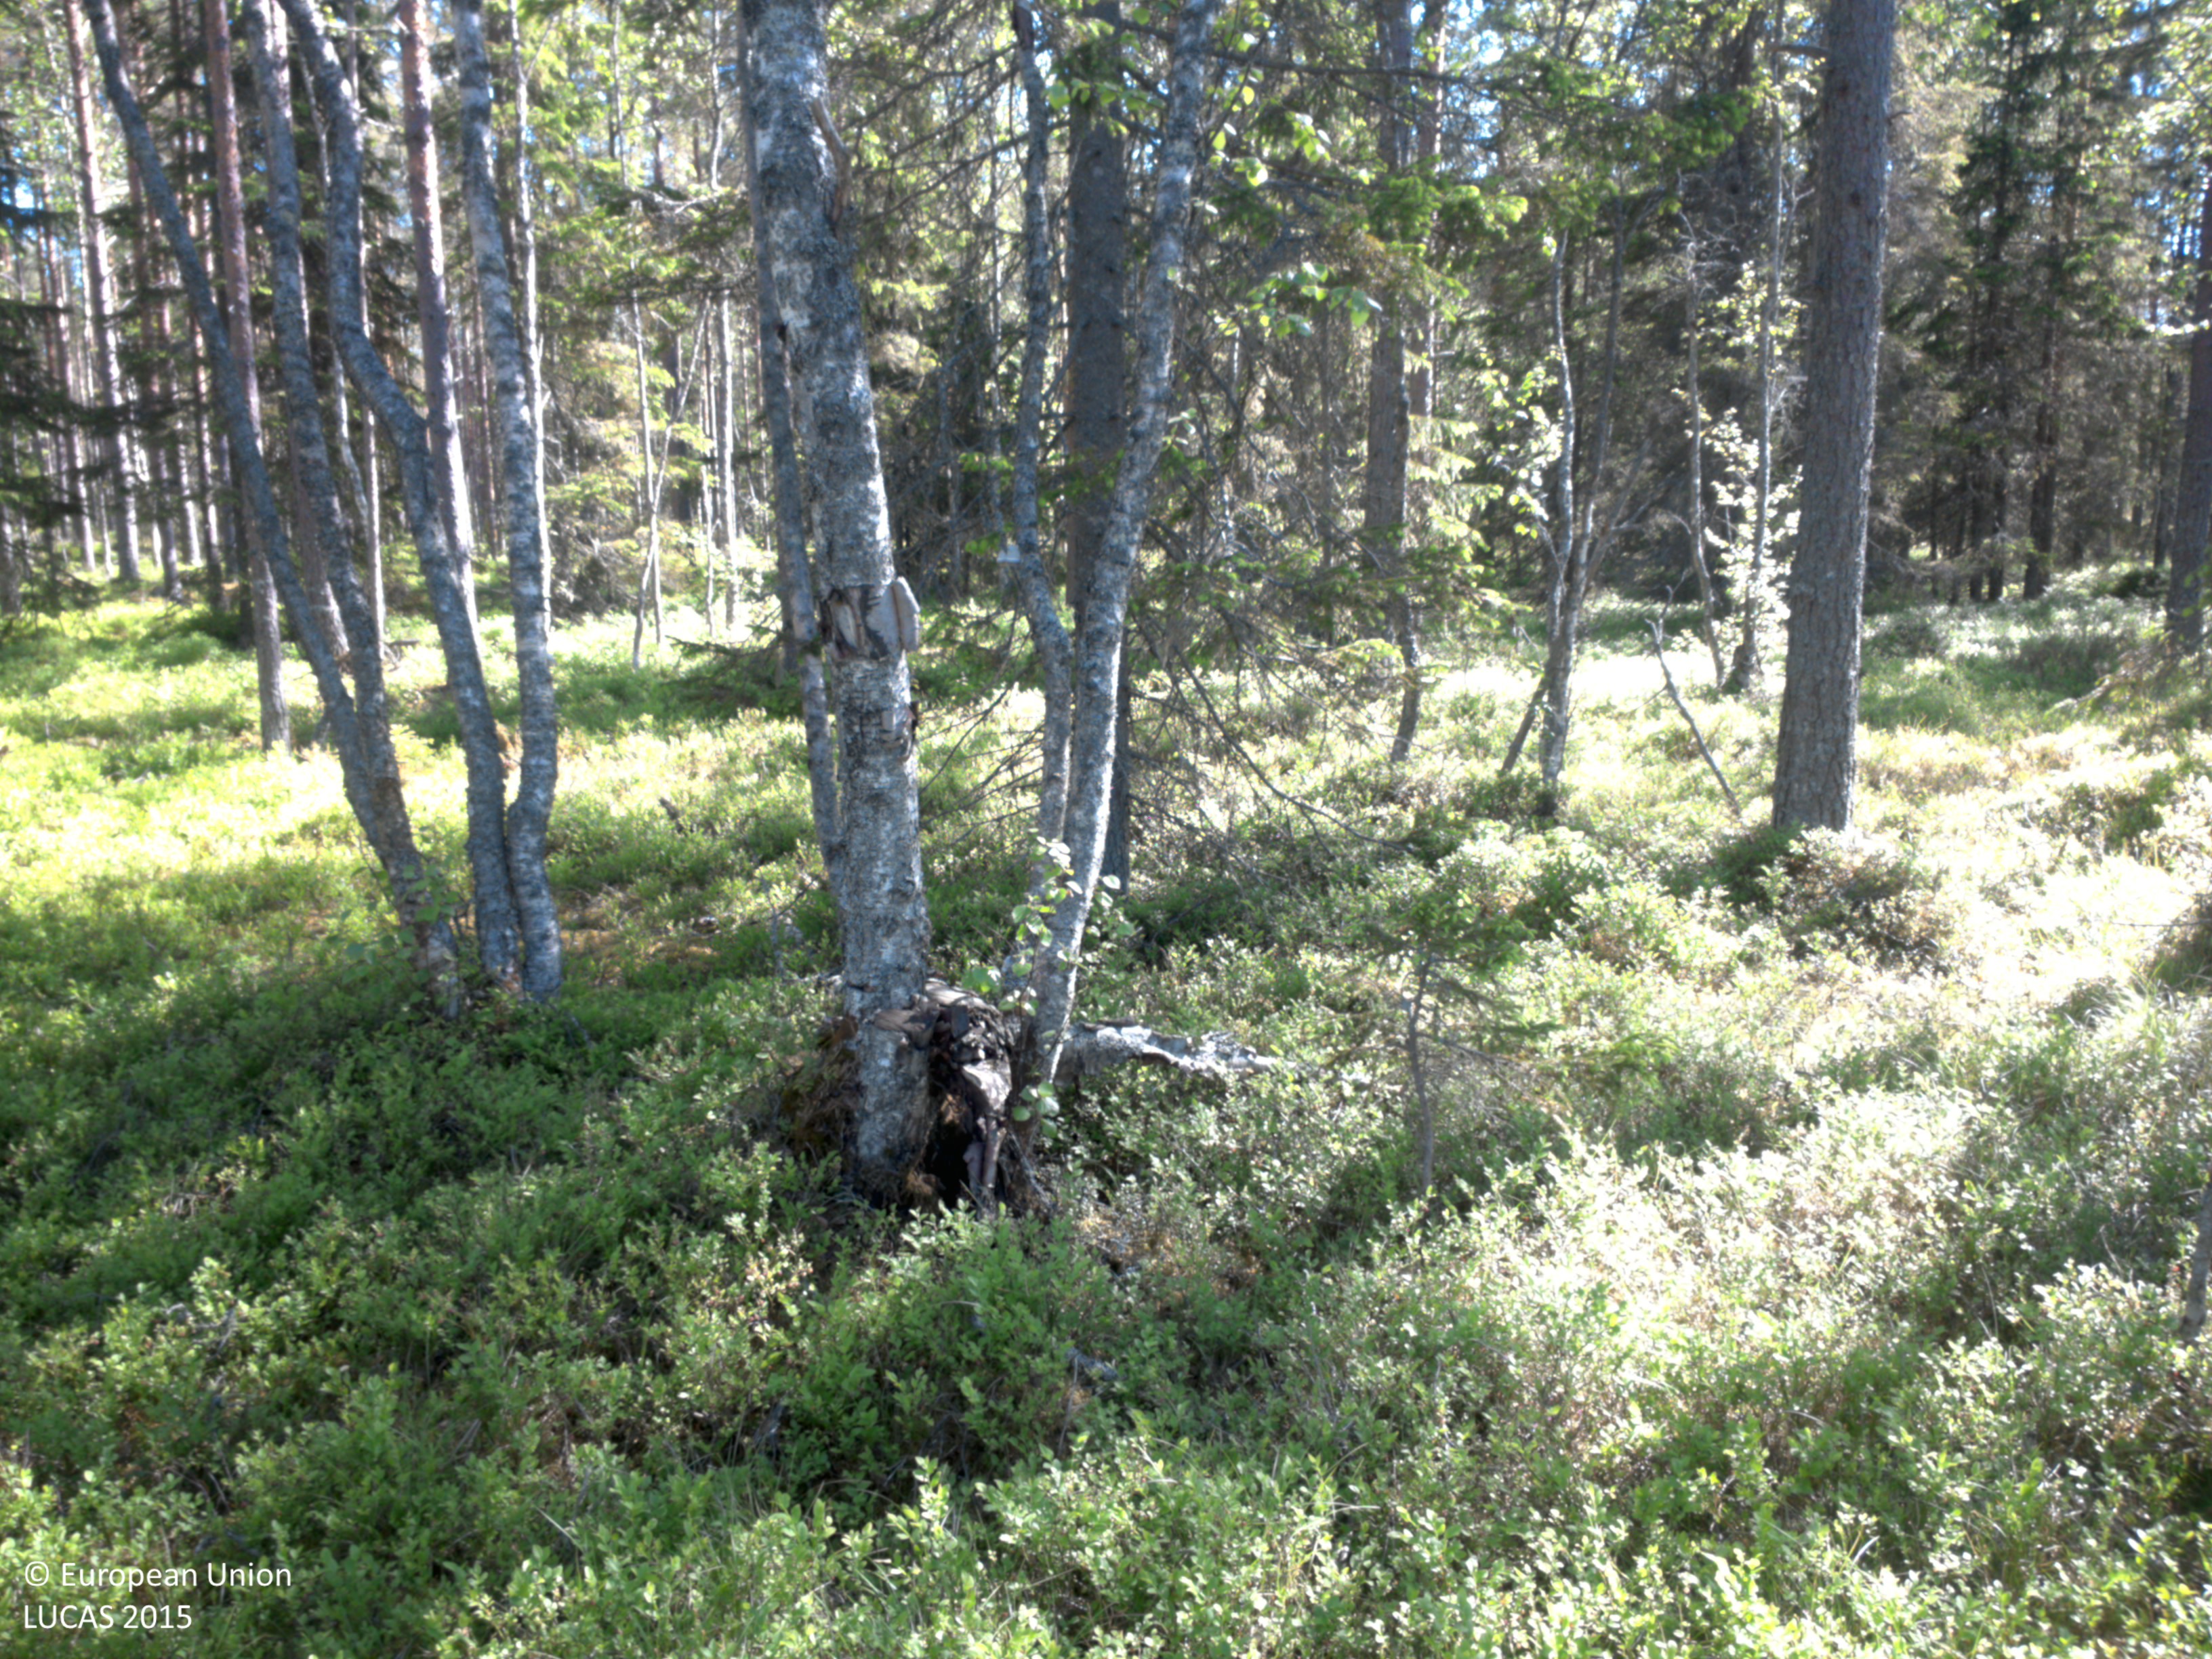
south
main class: Woodland
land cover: Pine dominated mixed woodland
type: boreal forest
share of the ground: 25 - 50 %
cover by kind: shrubs 50 %, coniferous forest trees 30 %, broadleaved forest trees 15 %, lichens and mosses 5 %
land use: Forestry
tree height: > 5 m
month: June
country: SE
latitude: 63.4651
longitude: 19.6719
